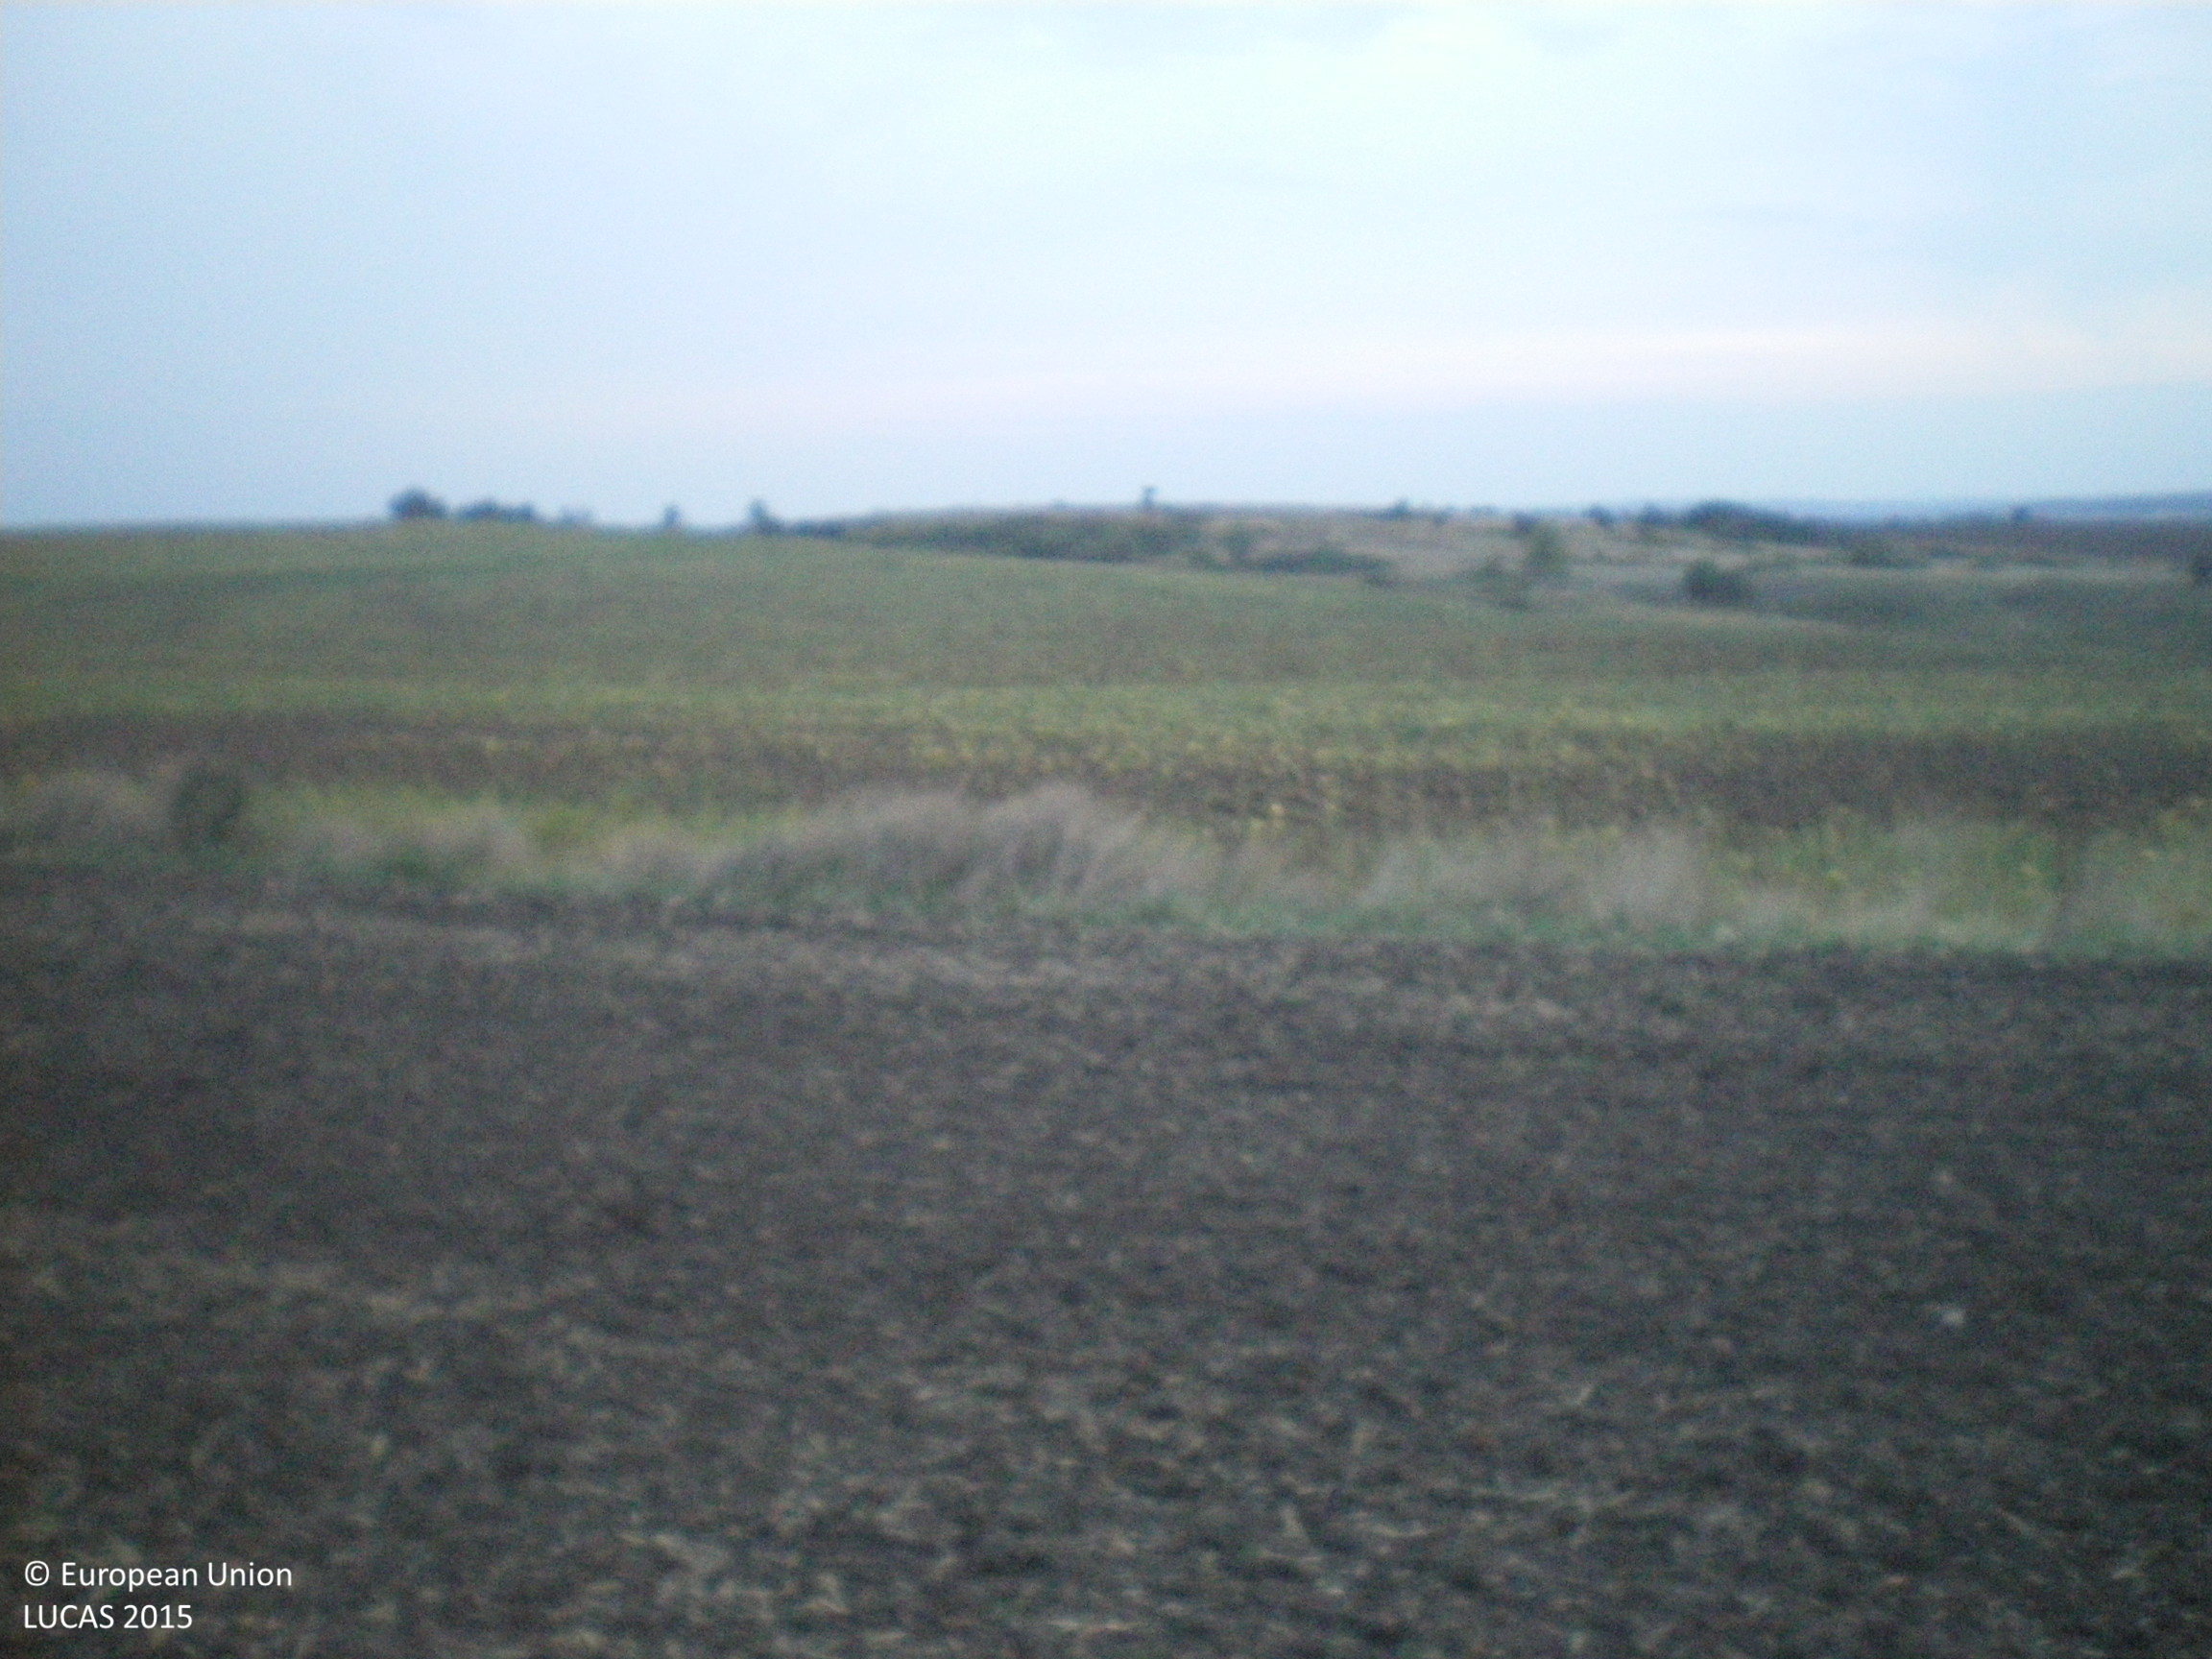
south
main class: Cropland
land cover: Common wheat
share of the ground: < 10 %
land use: Agriculture (excluding fallow land and kitchen gardens)
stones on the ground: < 10 %
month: September
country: BG
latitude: 42.1223
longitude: 25.9077
